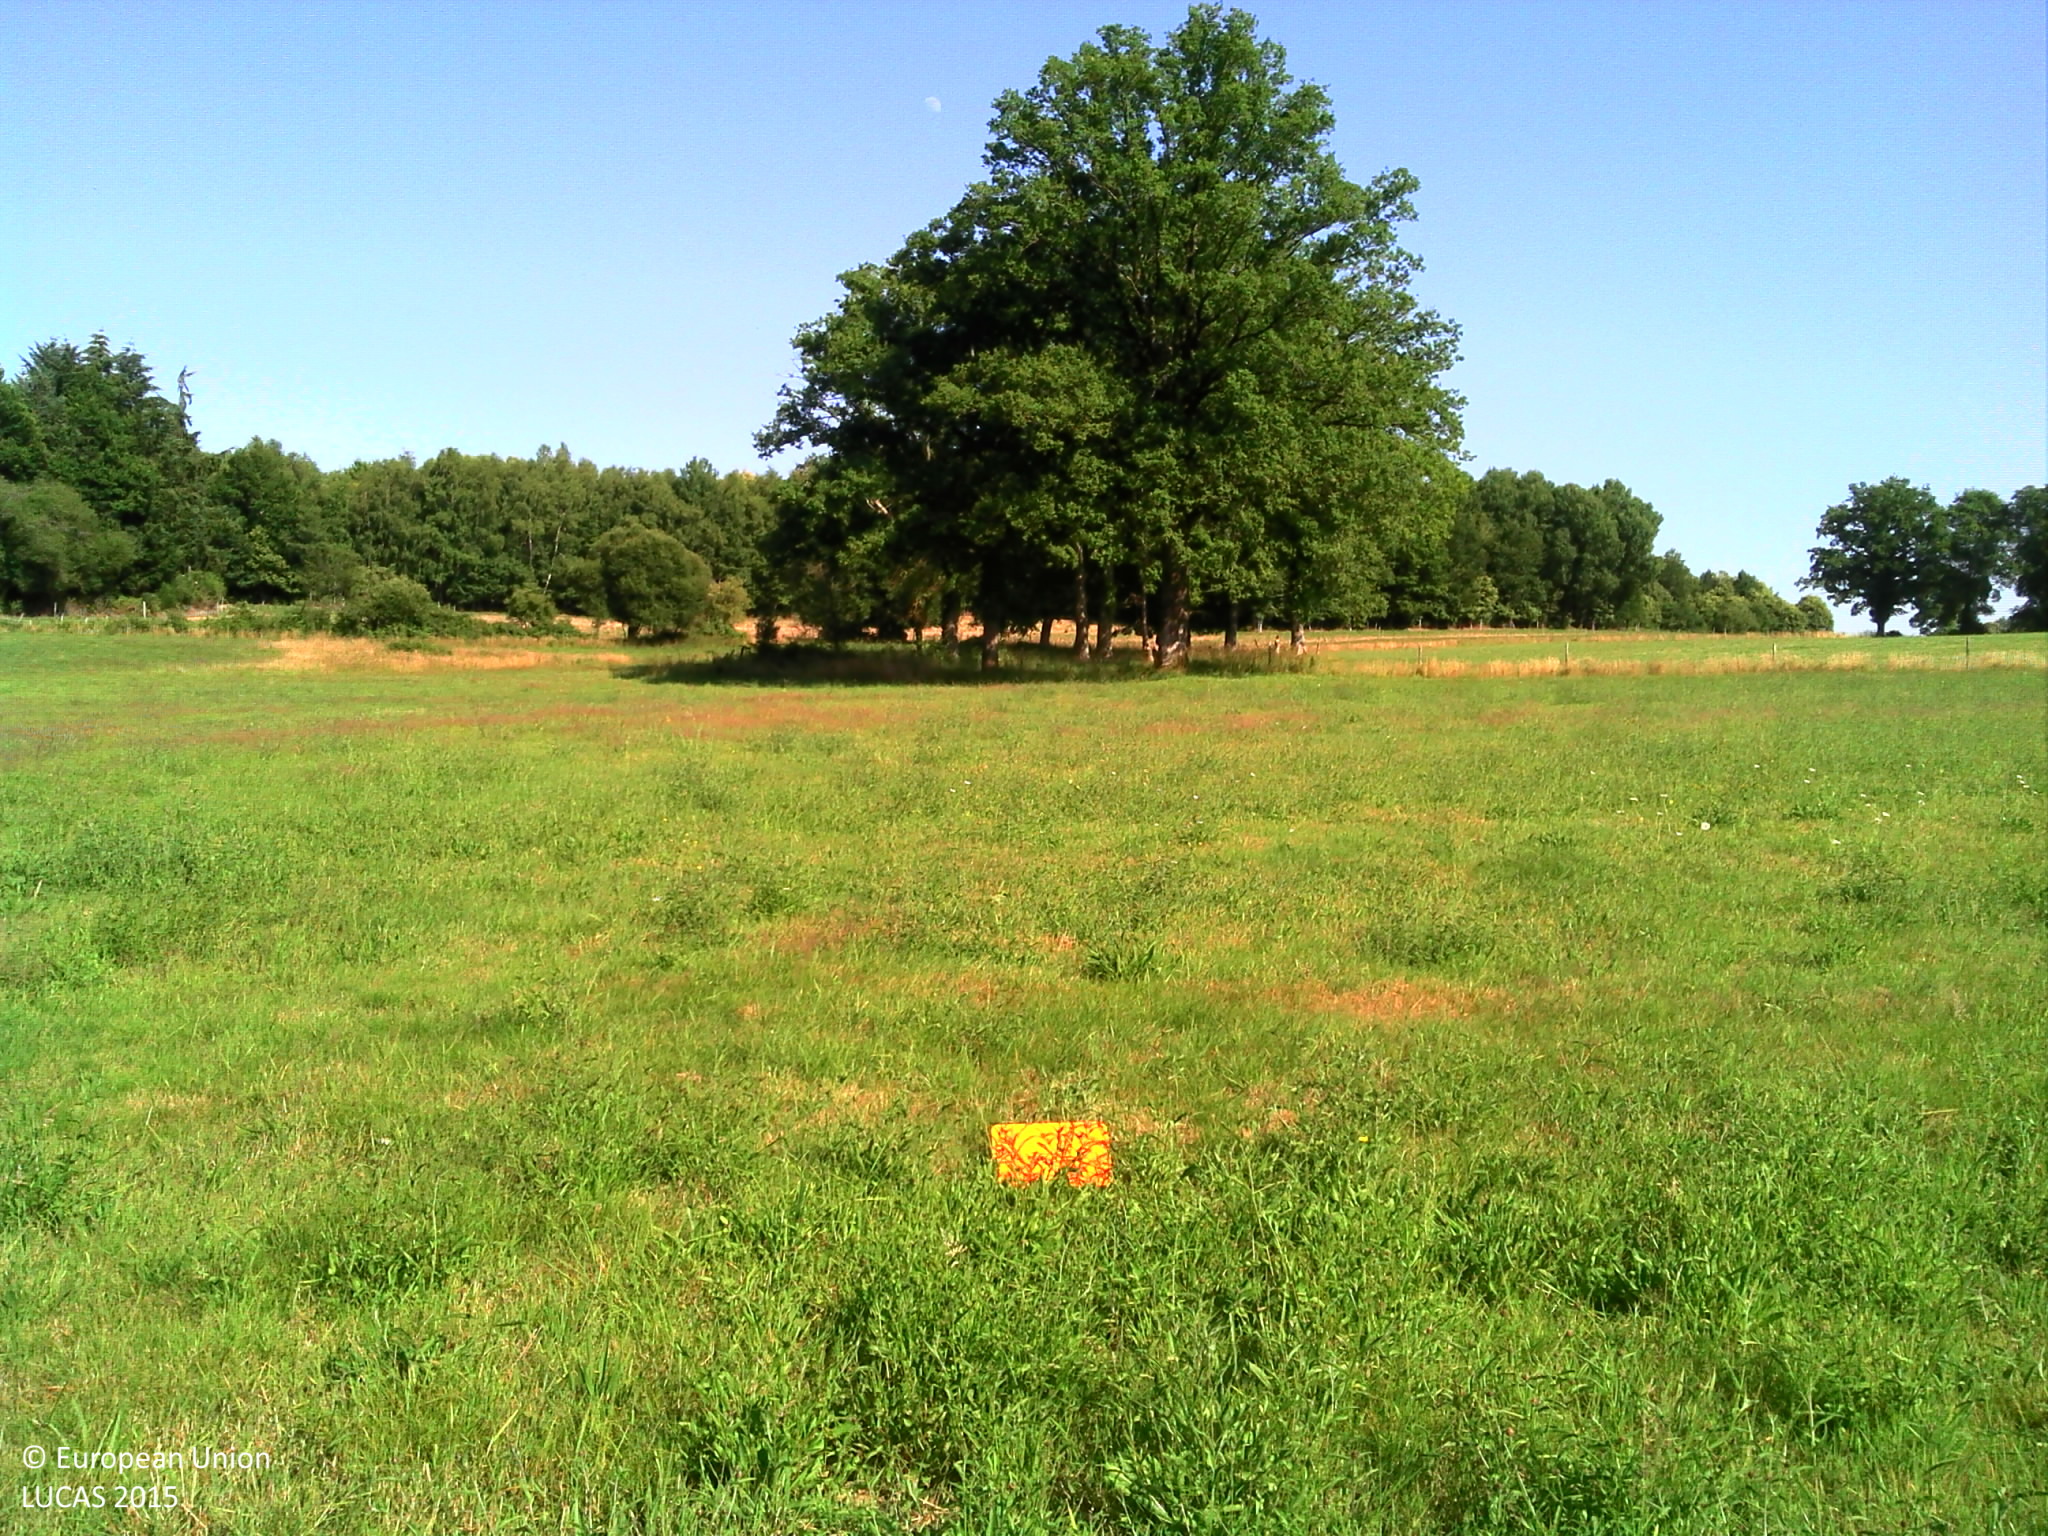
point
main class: Grassland
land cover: Grassland without tree/shrub cover
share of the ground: > 75 %
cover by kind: herbaceous plants 100 %
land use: Agriculture (excluding fallow land and kitchen gardens)
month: June
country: FR
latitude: 45.7564
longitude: 0.6146
